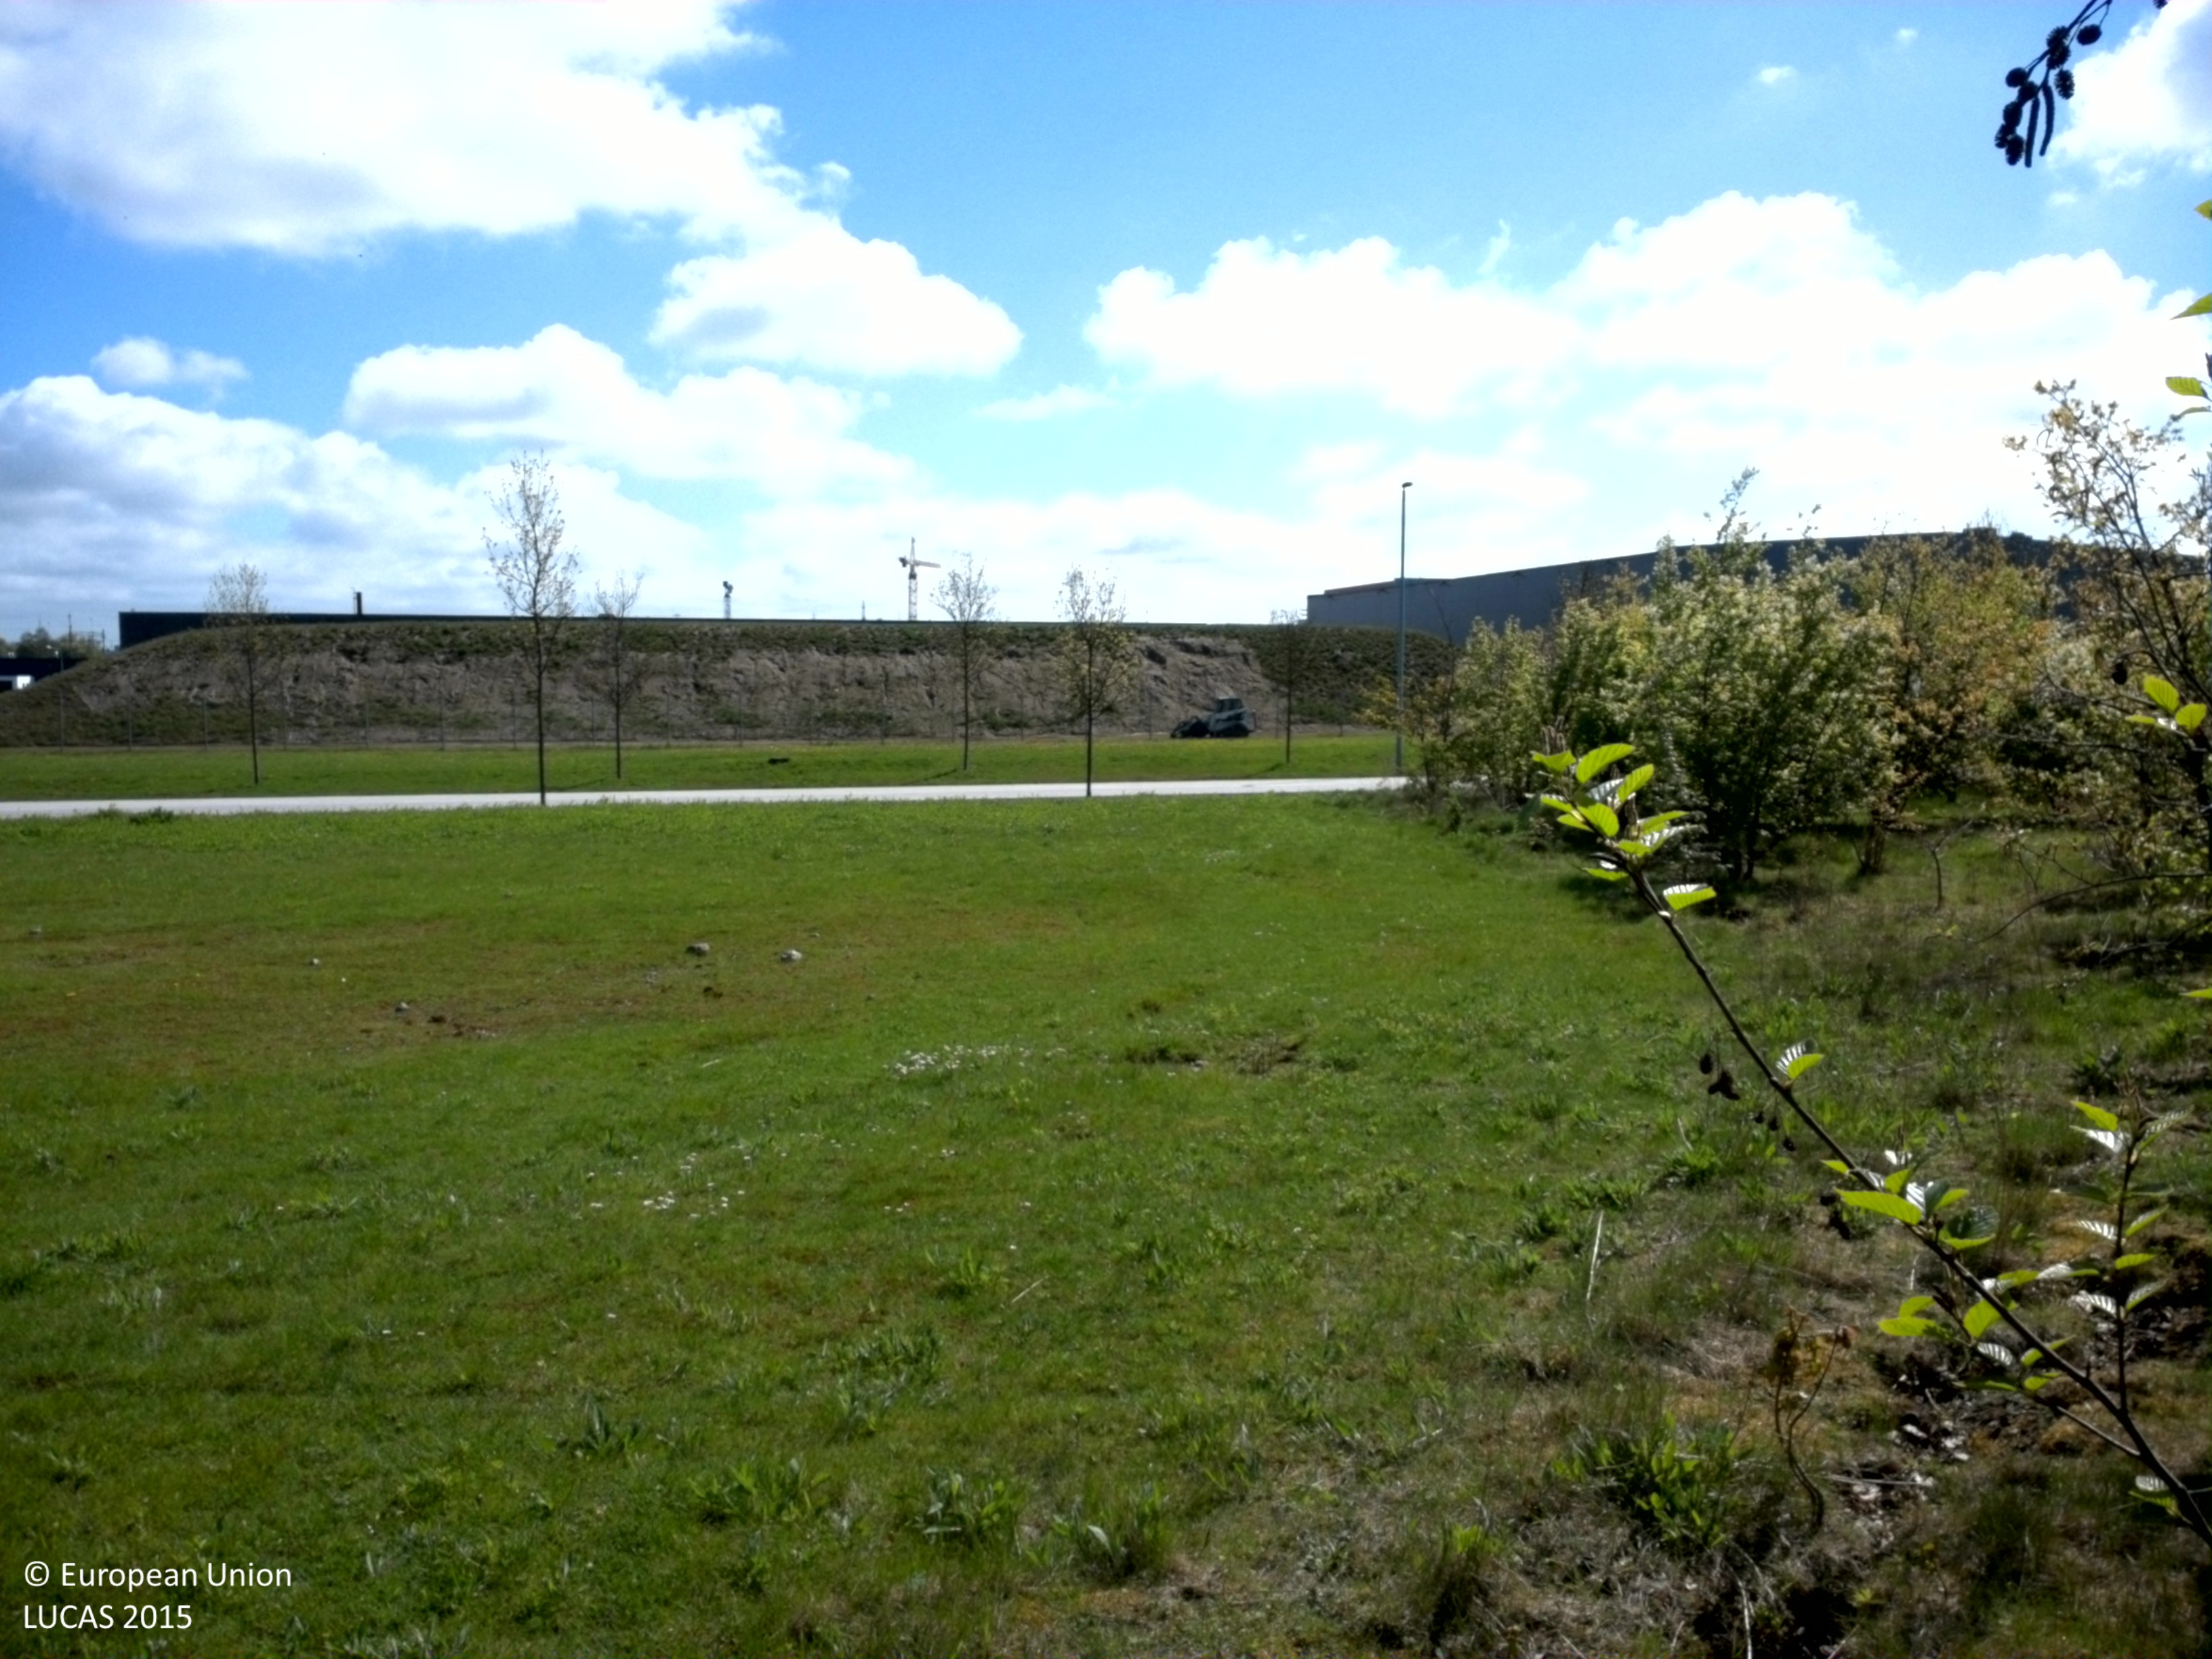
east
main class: Woodland
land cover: Broadleaved woodland
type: mesophytic deciduous forest
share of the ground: 50 - 75 %
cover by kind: broadleaved forest trees 75 %, shrubs 25 %
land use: Semi-natural and natural areas not in use
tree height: < 5 m
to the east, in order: Broadleaved woodland; Grassland without tree/shrub cover; Lines of trees; Grassland without tree/shrub cover; Paved roads, cycling and walking lanes; Grassland without tree/shrub cover; Lines of trees; Grassland without tree/shrub cover; Artificial constructions in urban areas
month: May
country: SE
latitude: 55.5585
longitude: 13.0262
